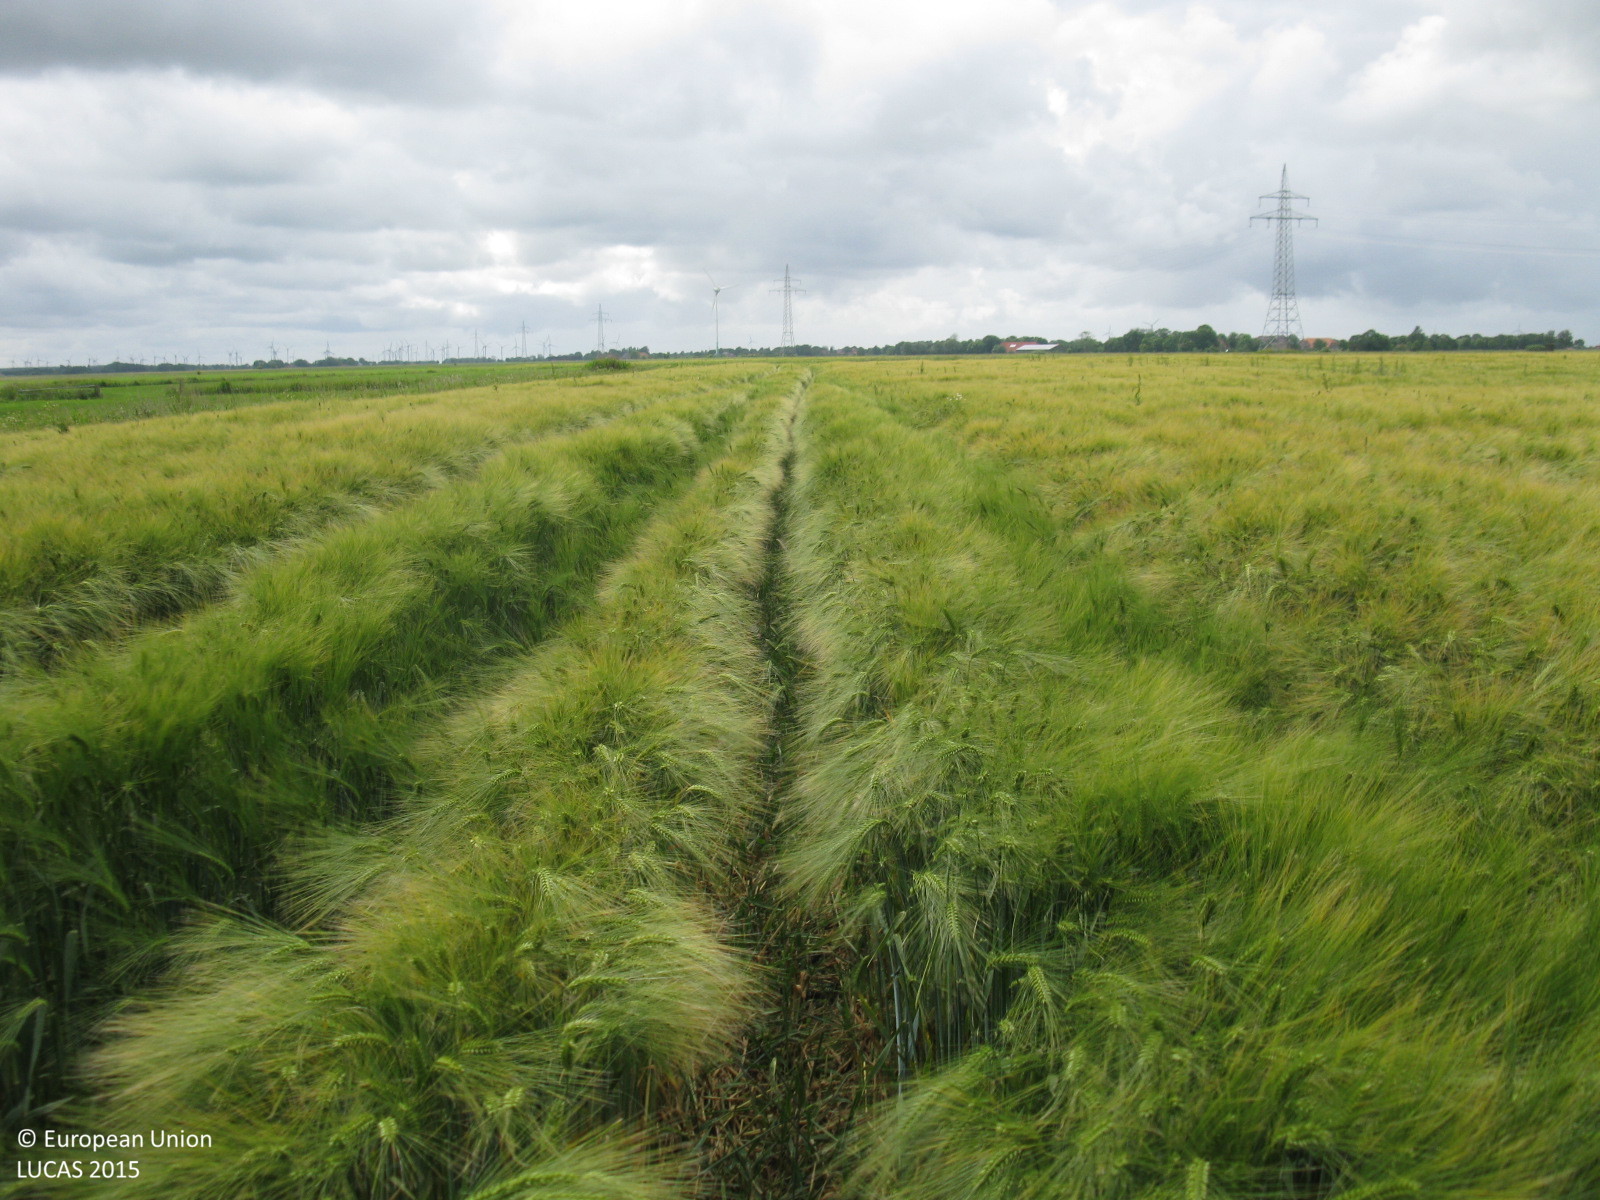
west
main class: Cropland
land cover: Barley
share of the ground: > 75 %
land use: Agriculture (excluding fallow land and kitchen gardens)
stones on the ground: < 10 %
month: June
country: DE
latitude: 53.6428
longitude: 7.3536
